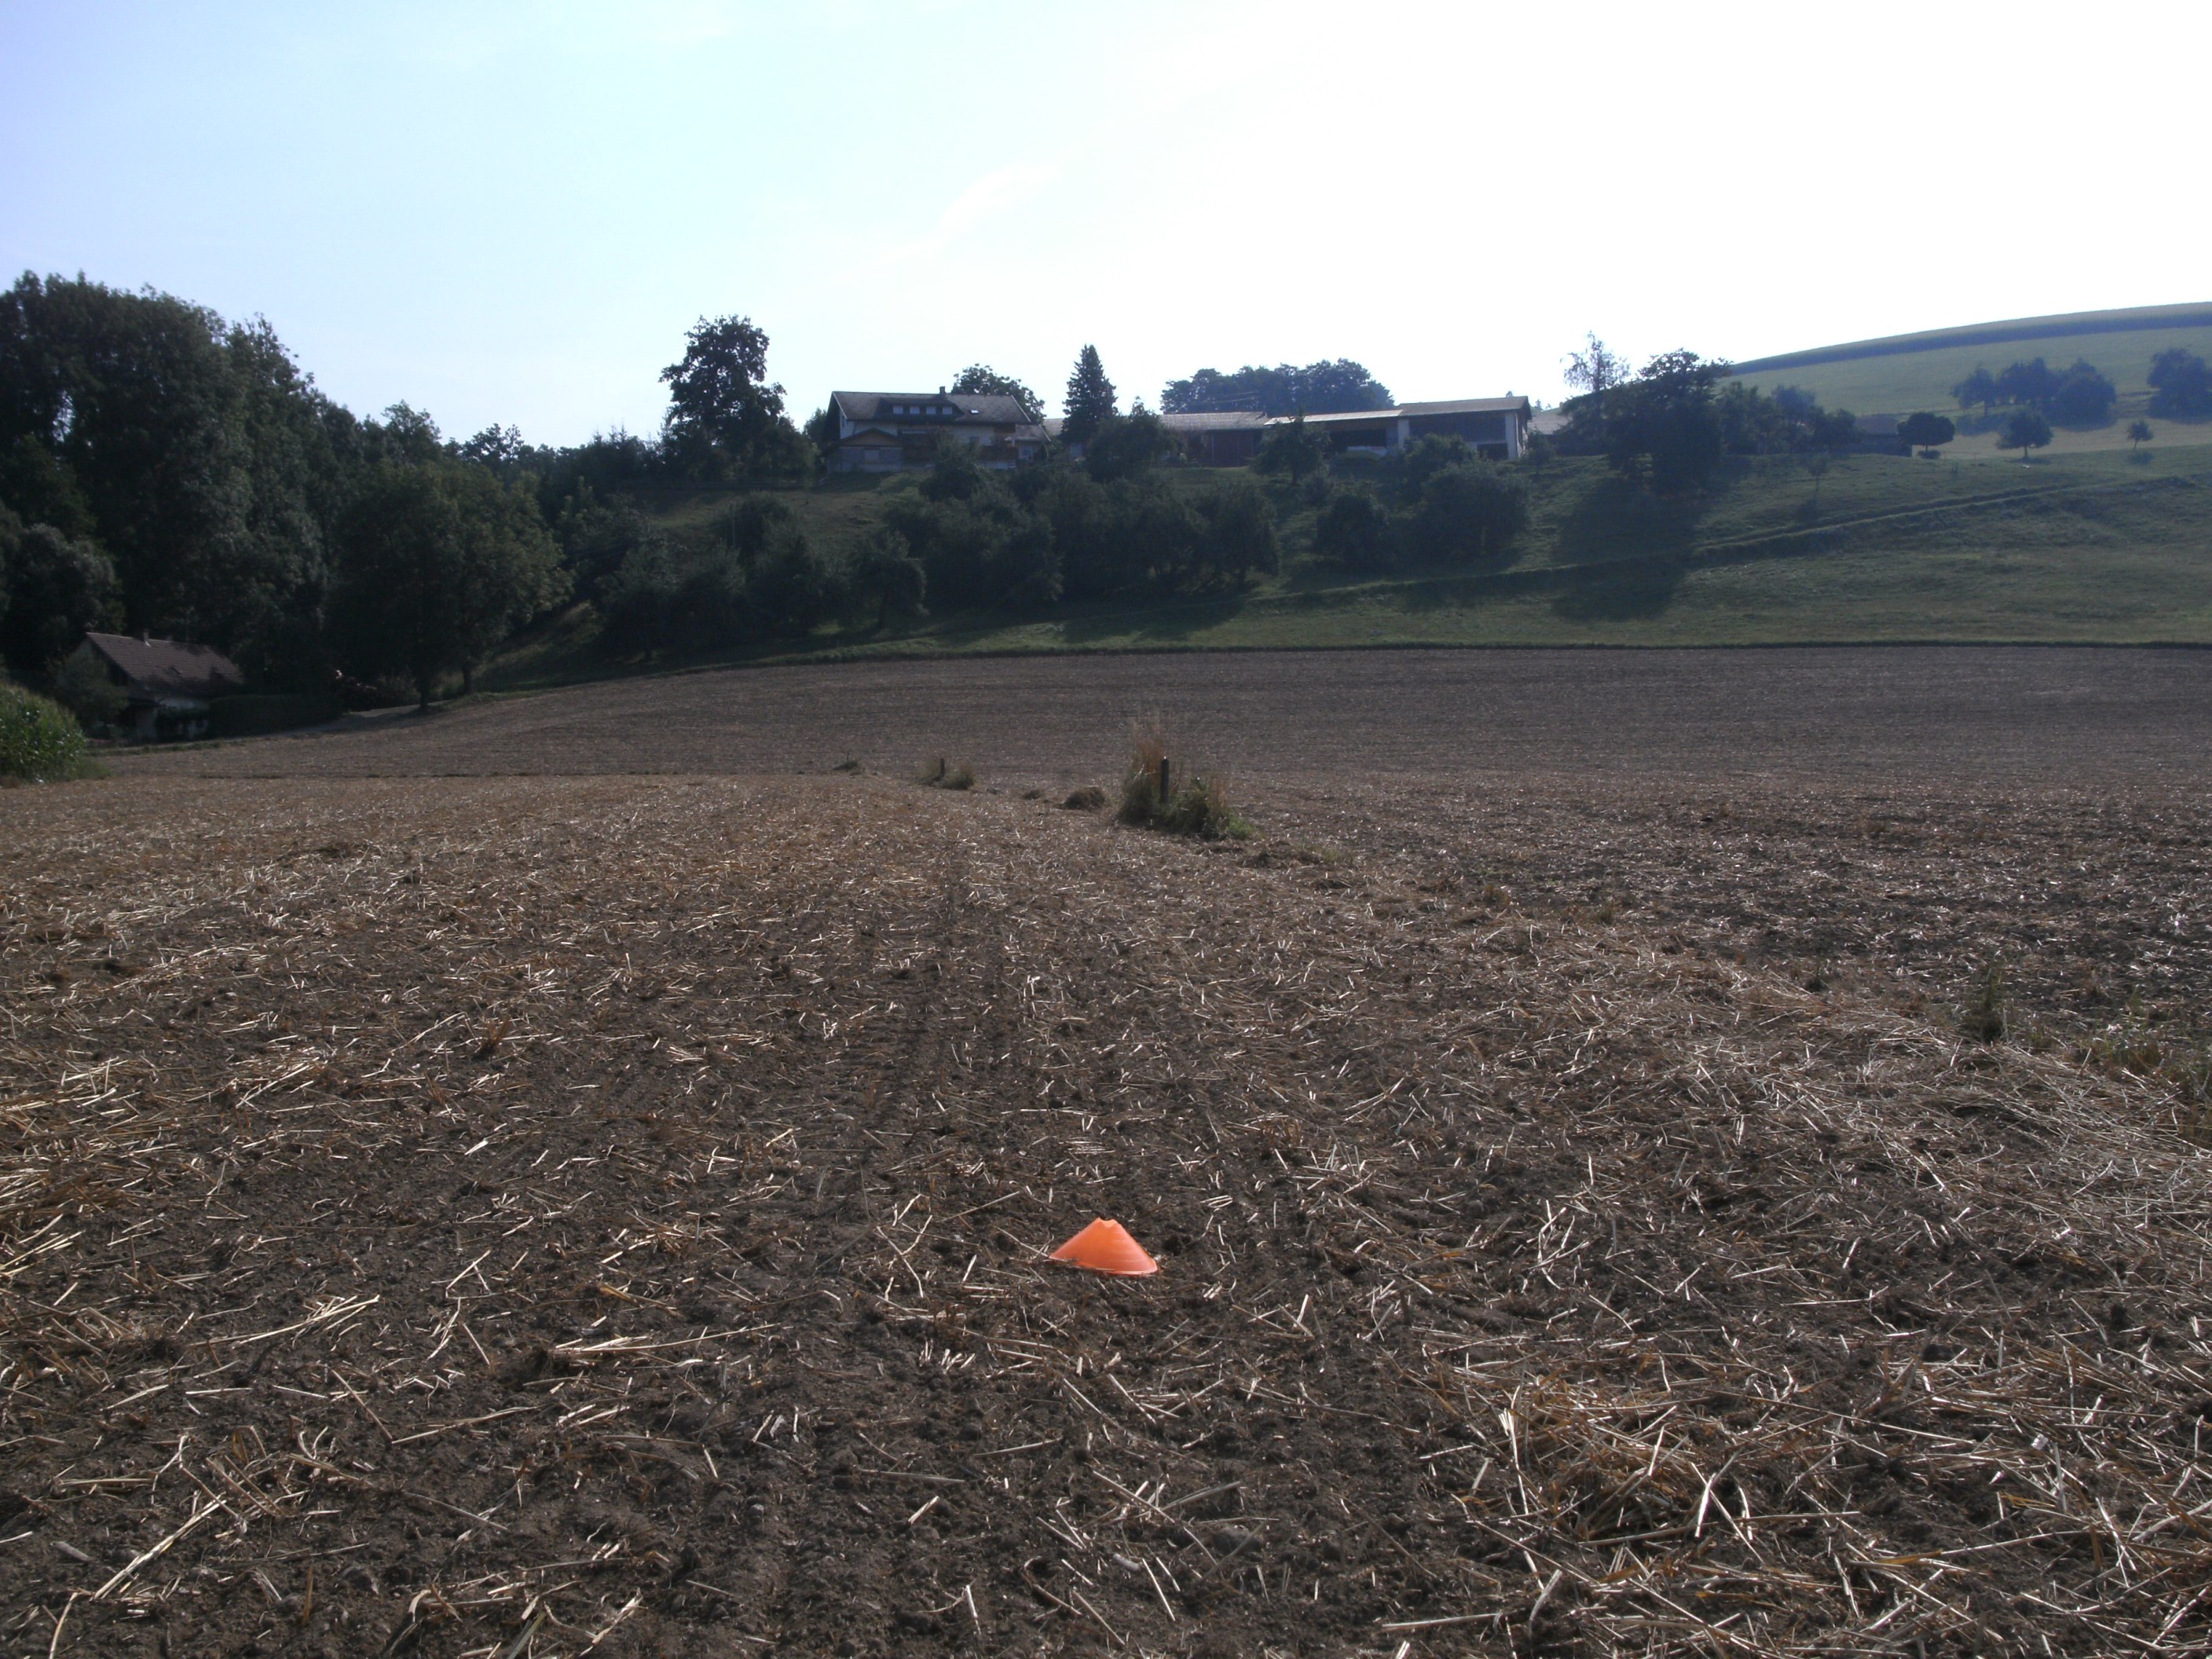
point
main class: Cropland
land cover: Common wheat
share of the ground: < 10 %
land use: Agriculture (excluding fallow land and kitchen gardens)
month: July
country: AT
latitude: 46.7091
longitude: 14.8772
